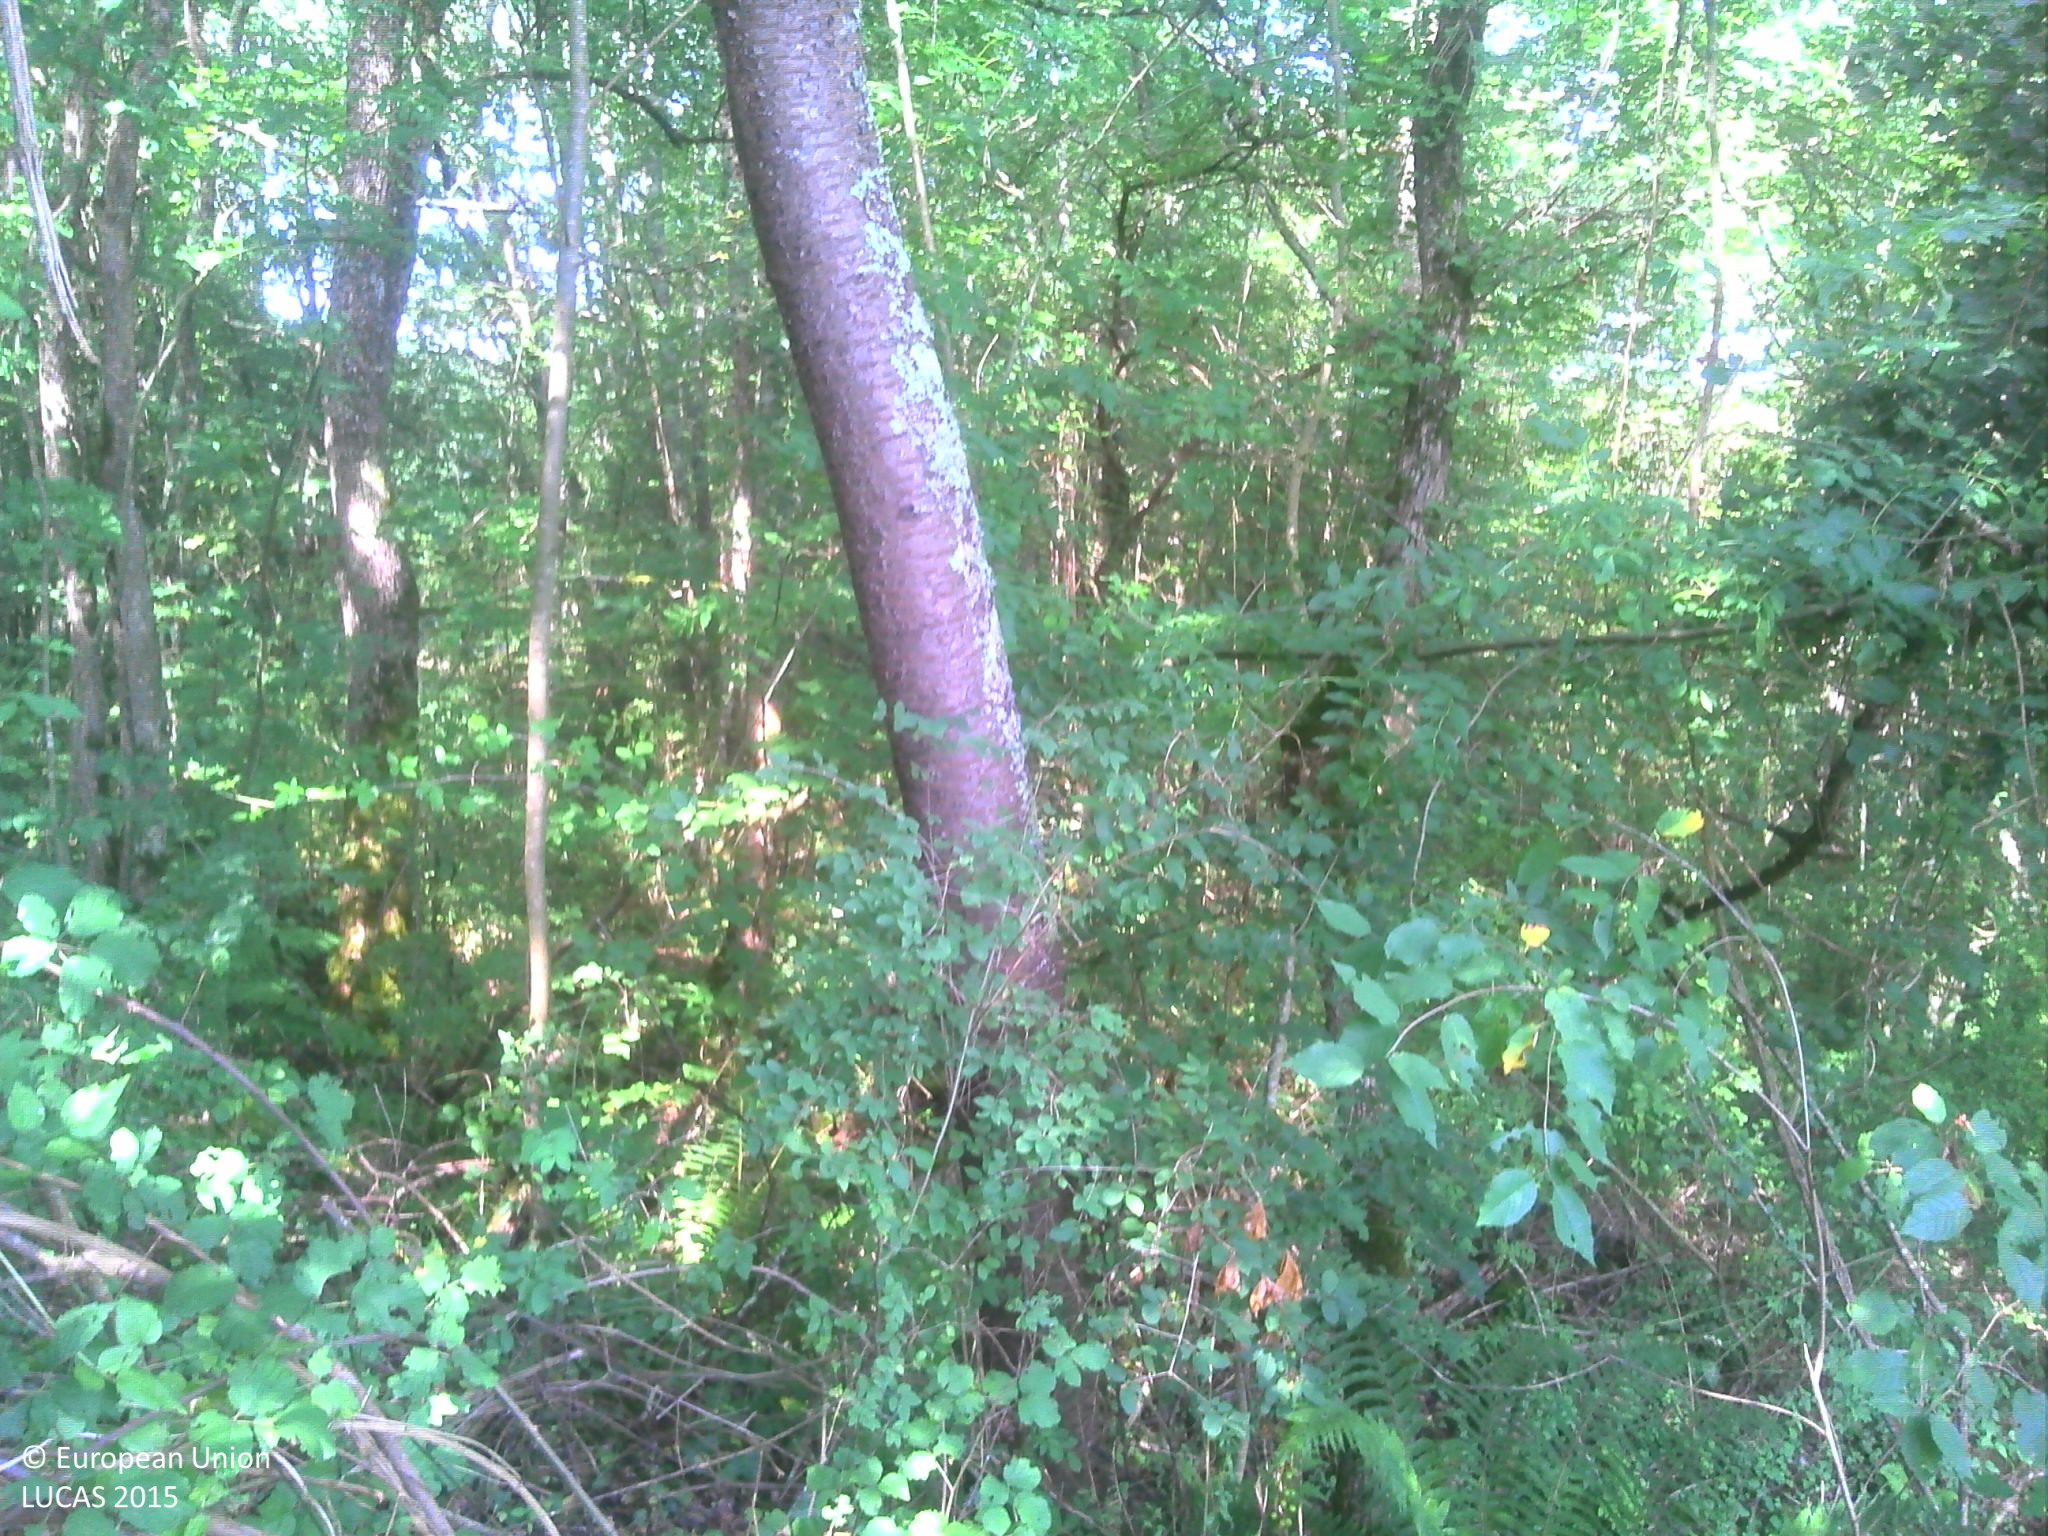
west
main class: Woodland
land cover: Broadleaved woodland
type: acidophilous oak and oak-birch forest
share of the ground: > 75 %
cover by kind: broadleaved forest trees 50 %, shrubs 20 %, herbaceous plants 20 %, consolidated bare surface 10 %
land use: Forestry
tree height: > 5 m
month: July
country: FR
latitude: 43.0725
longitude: 0.8286
